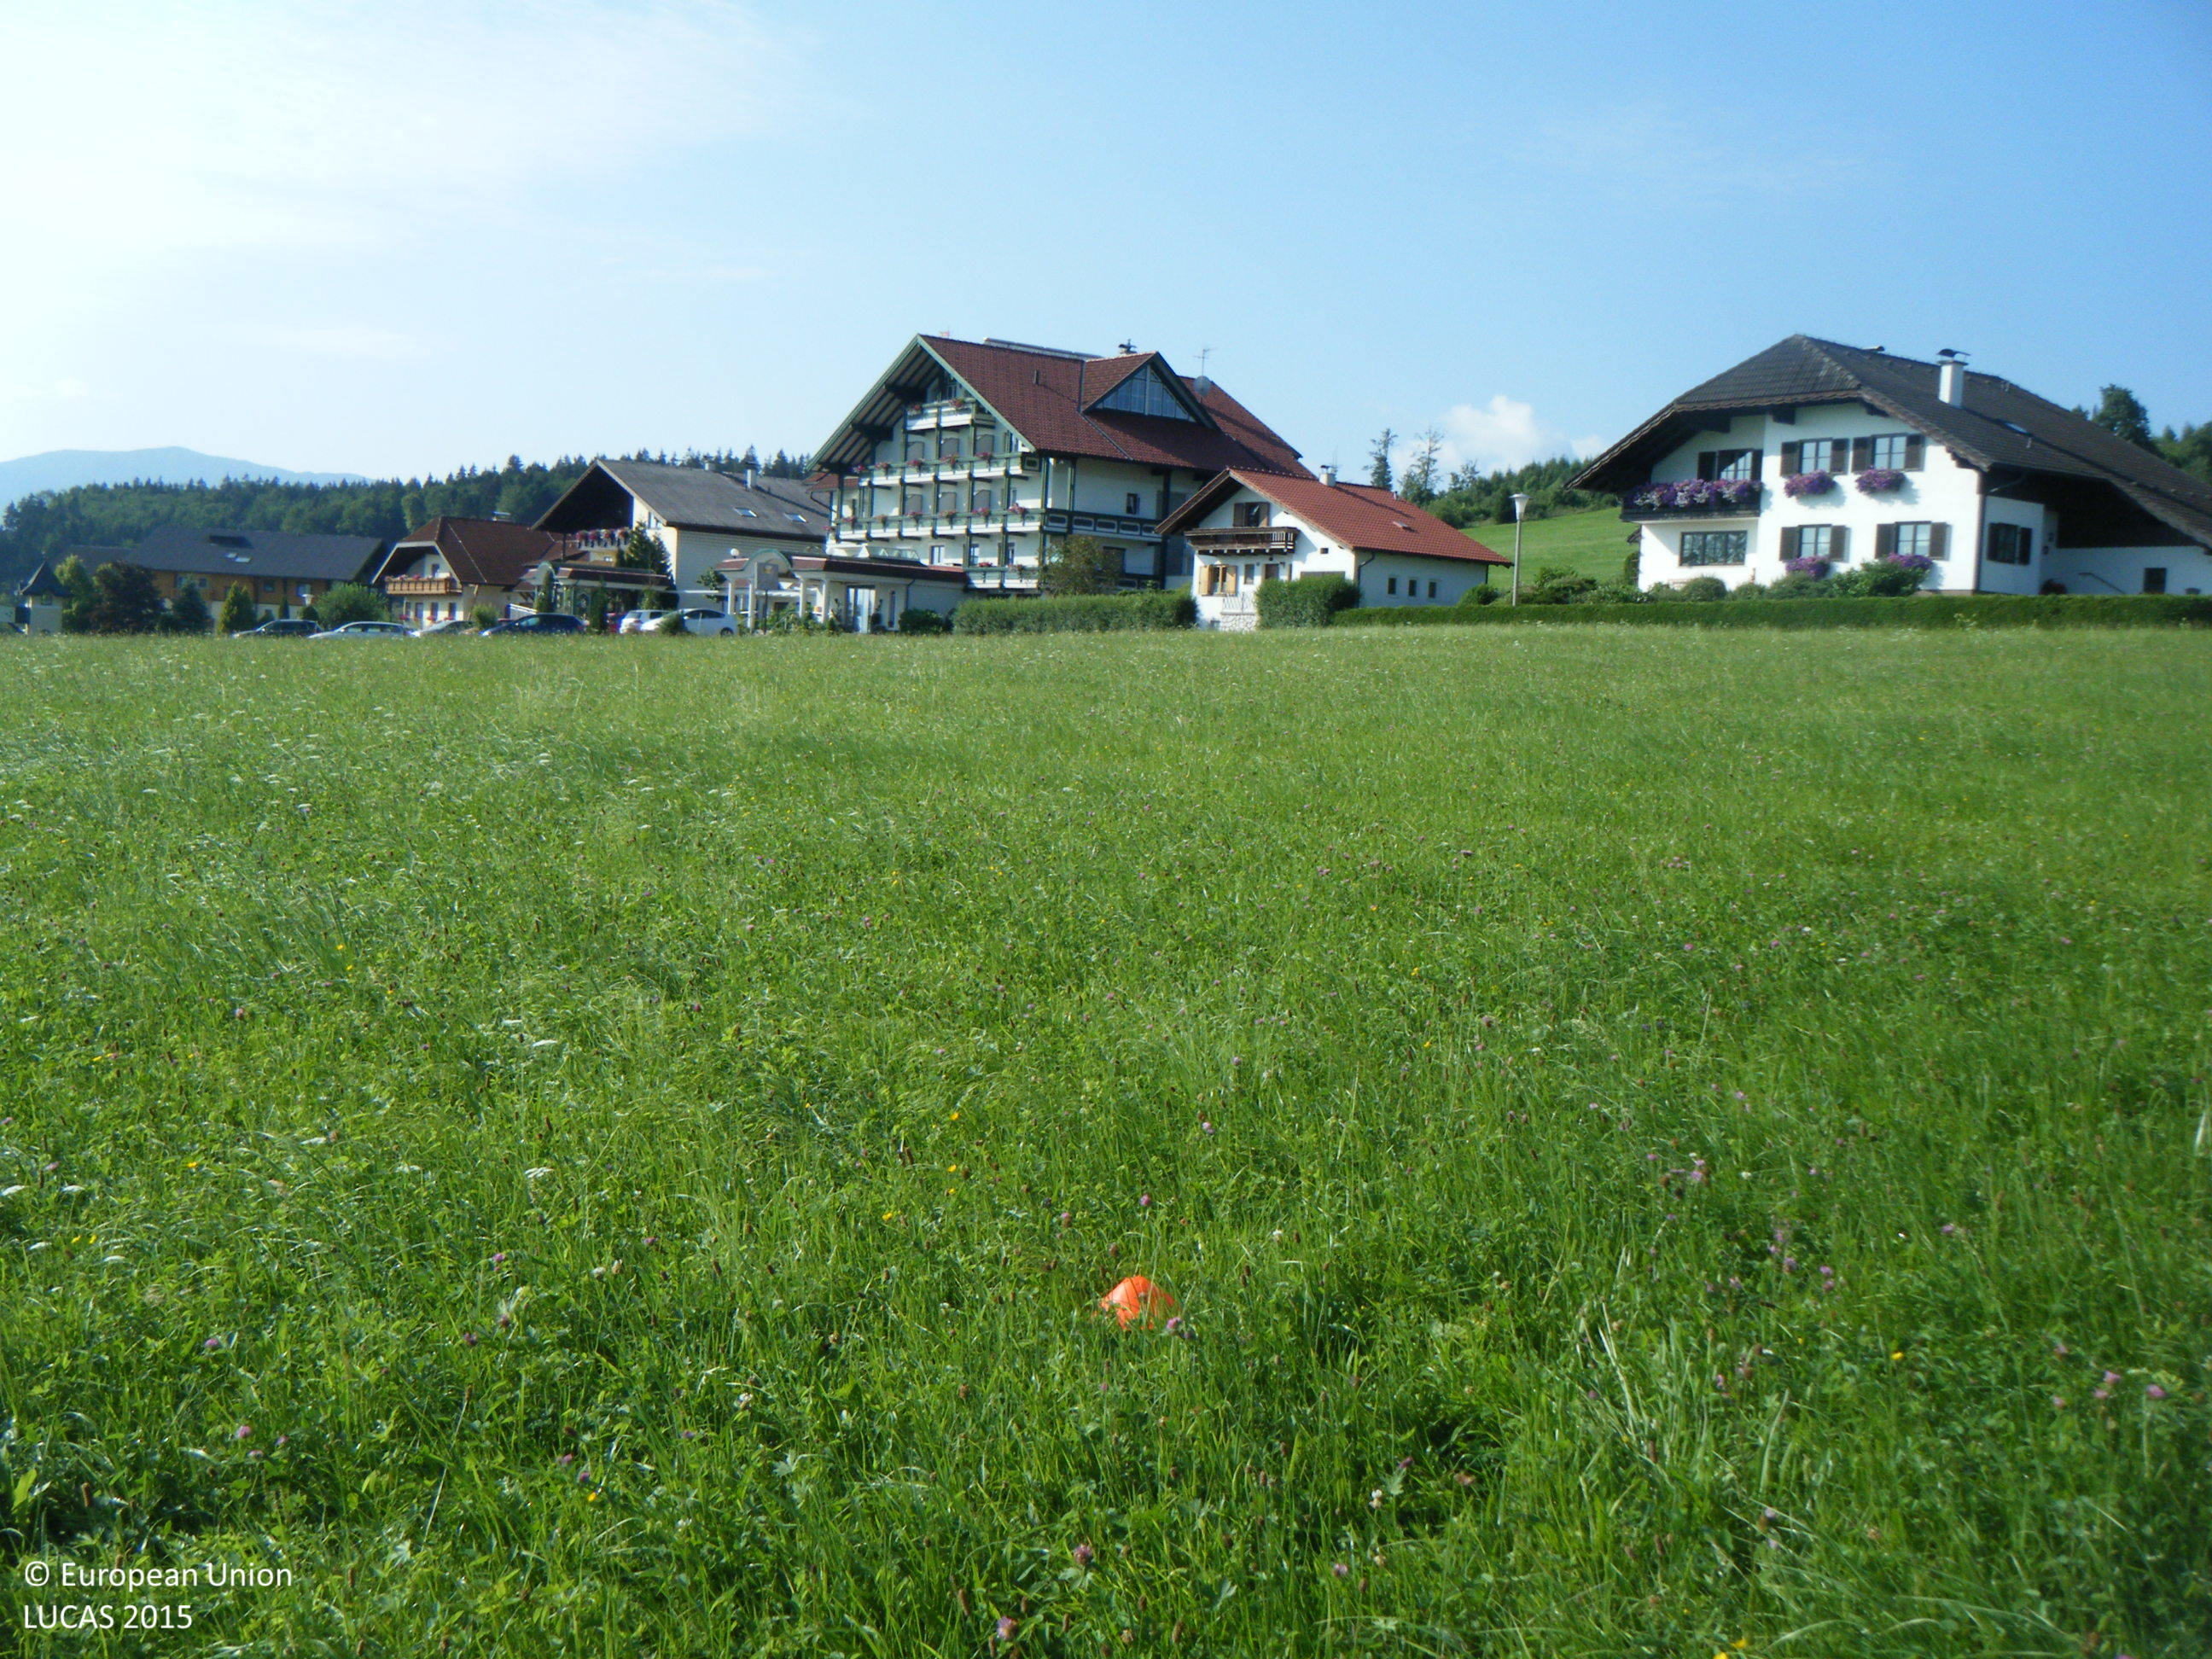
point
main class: Grassland
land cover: Grassland without tree/shrub cover
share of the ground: > 75 %
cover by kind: herbaceous plants 100 %
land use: Agriculture (excluding fallow land and kitchen gardens)
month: July
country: AT
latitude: 47.8981
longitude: 13.4901
